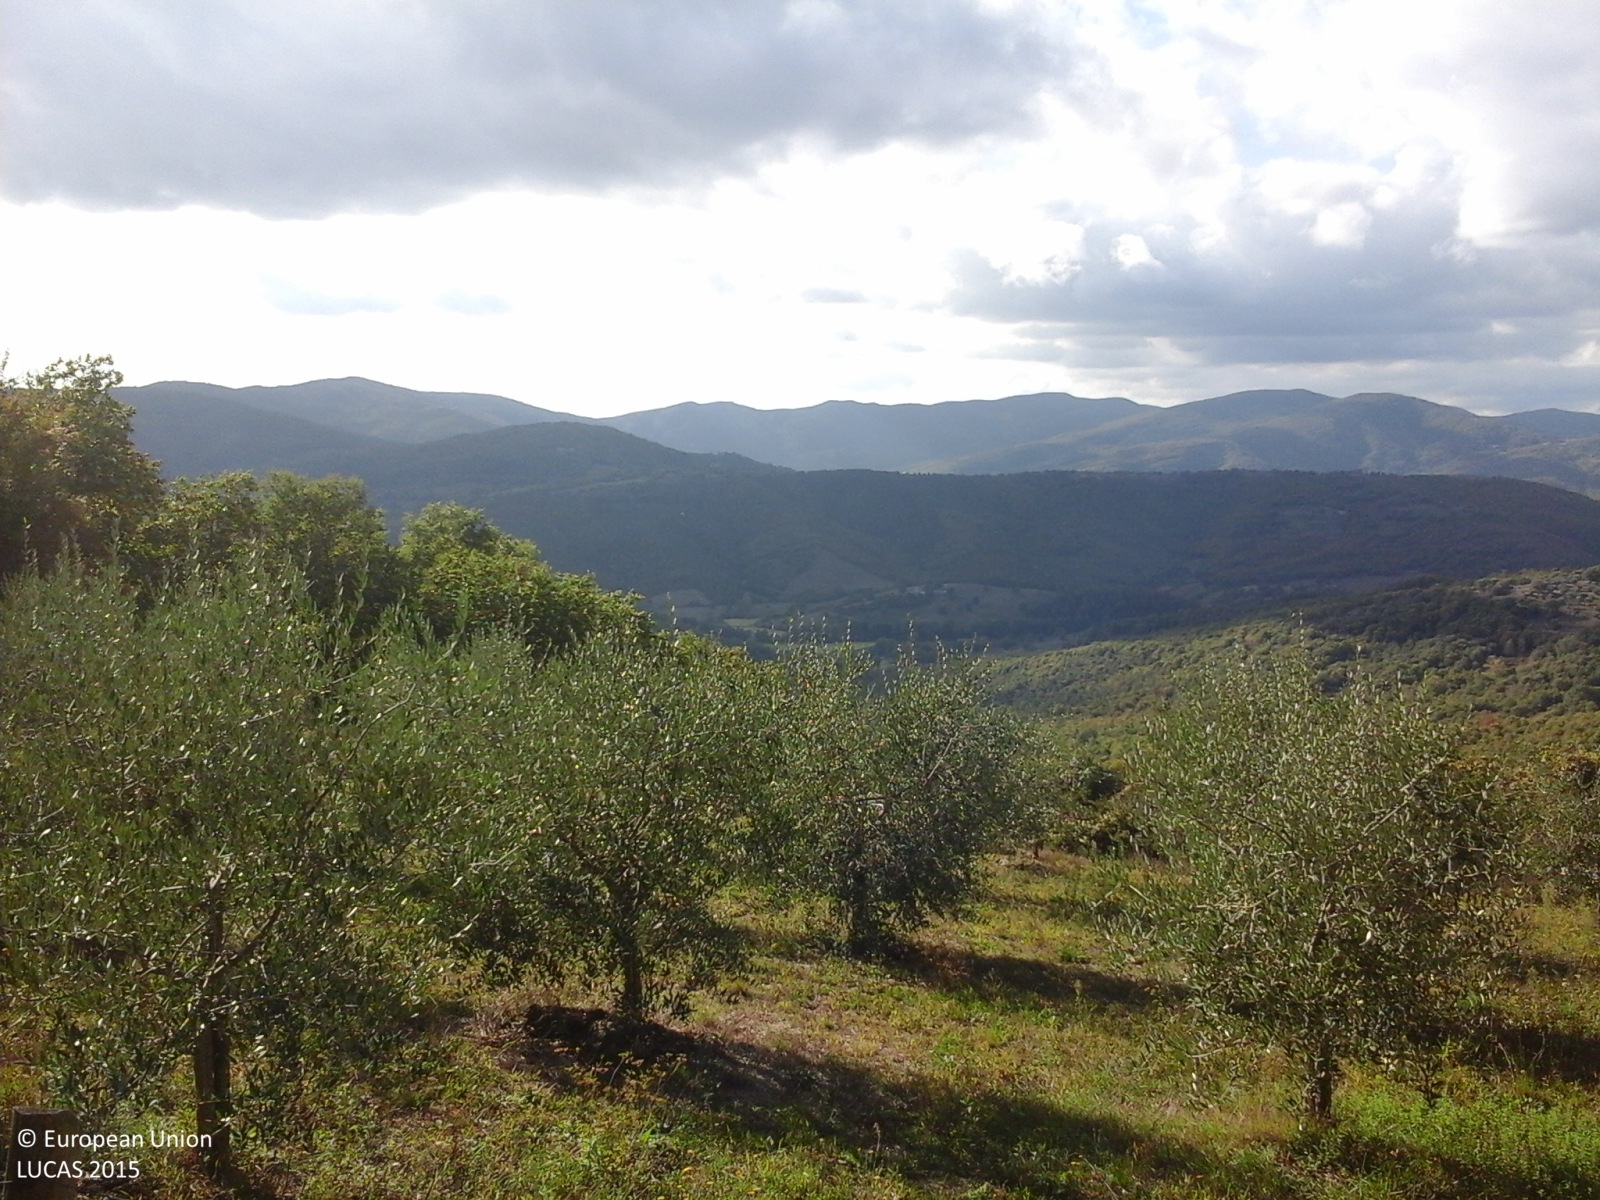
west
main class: Cropland
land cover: Olive groves
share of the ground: 50 - 75 %
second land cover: Spontaneously vegetated surfaces
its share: > 75 %
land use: Agriculture (excluding fallow land and kitchen gardens)
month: October
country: IT
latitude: 43.2438
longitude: 12.2228
